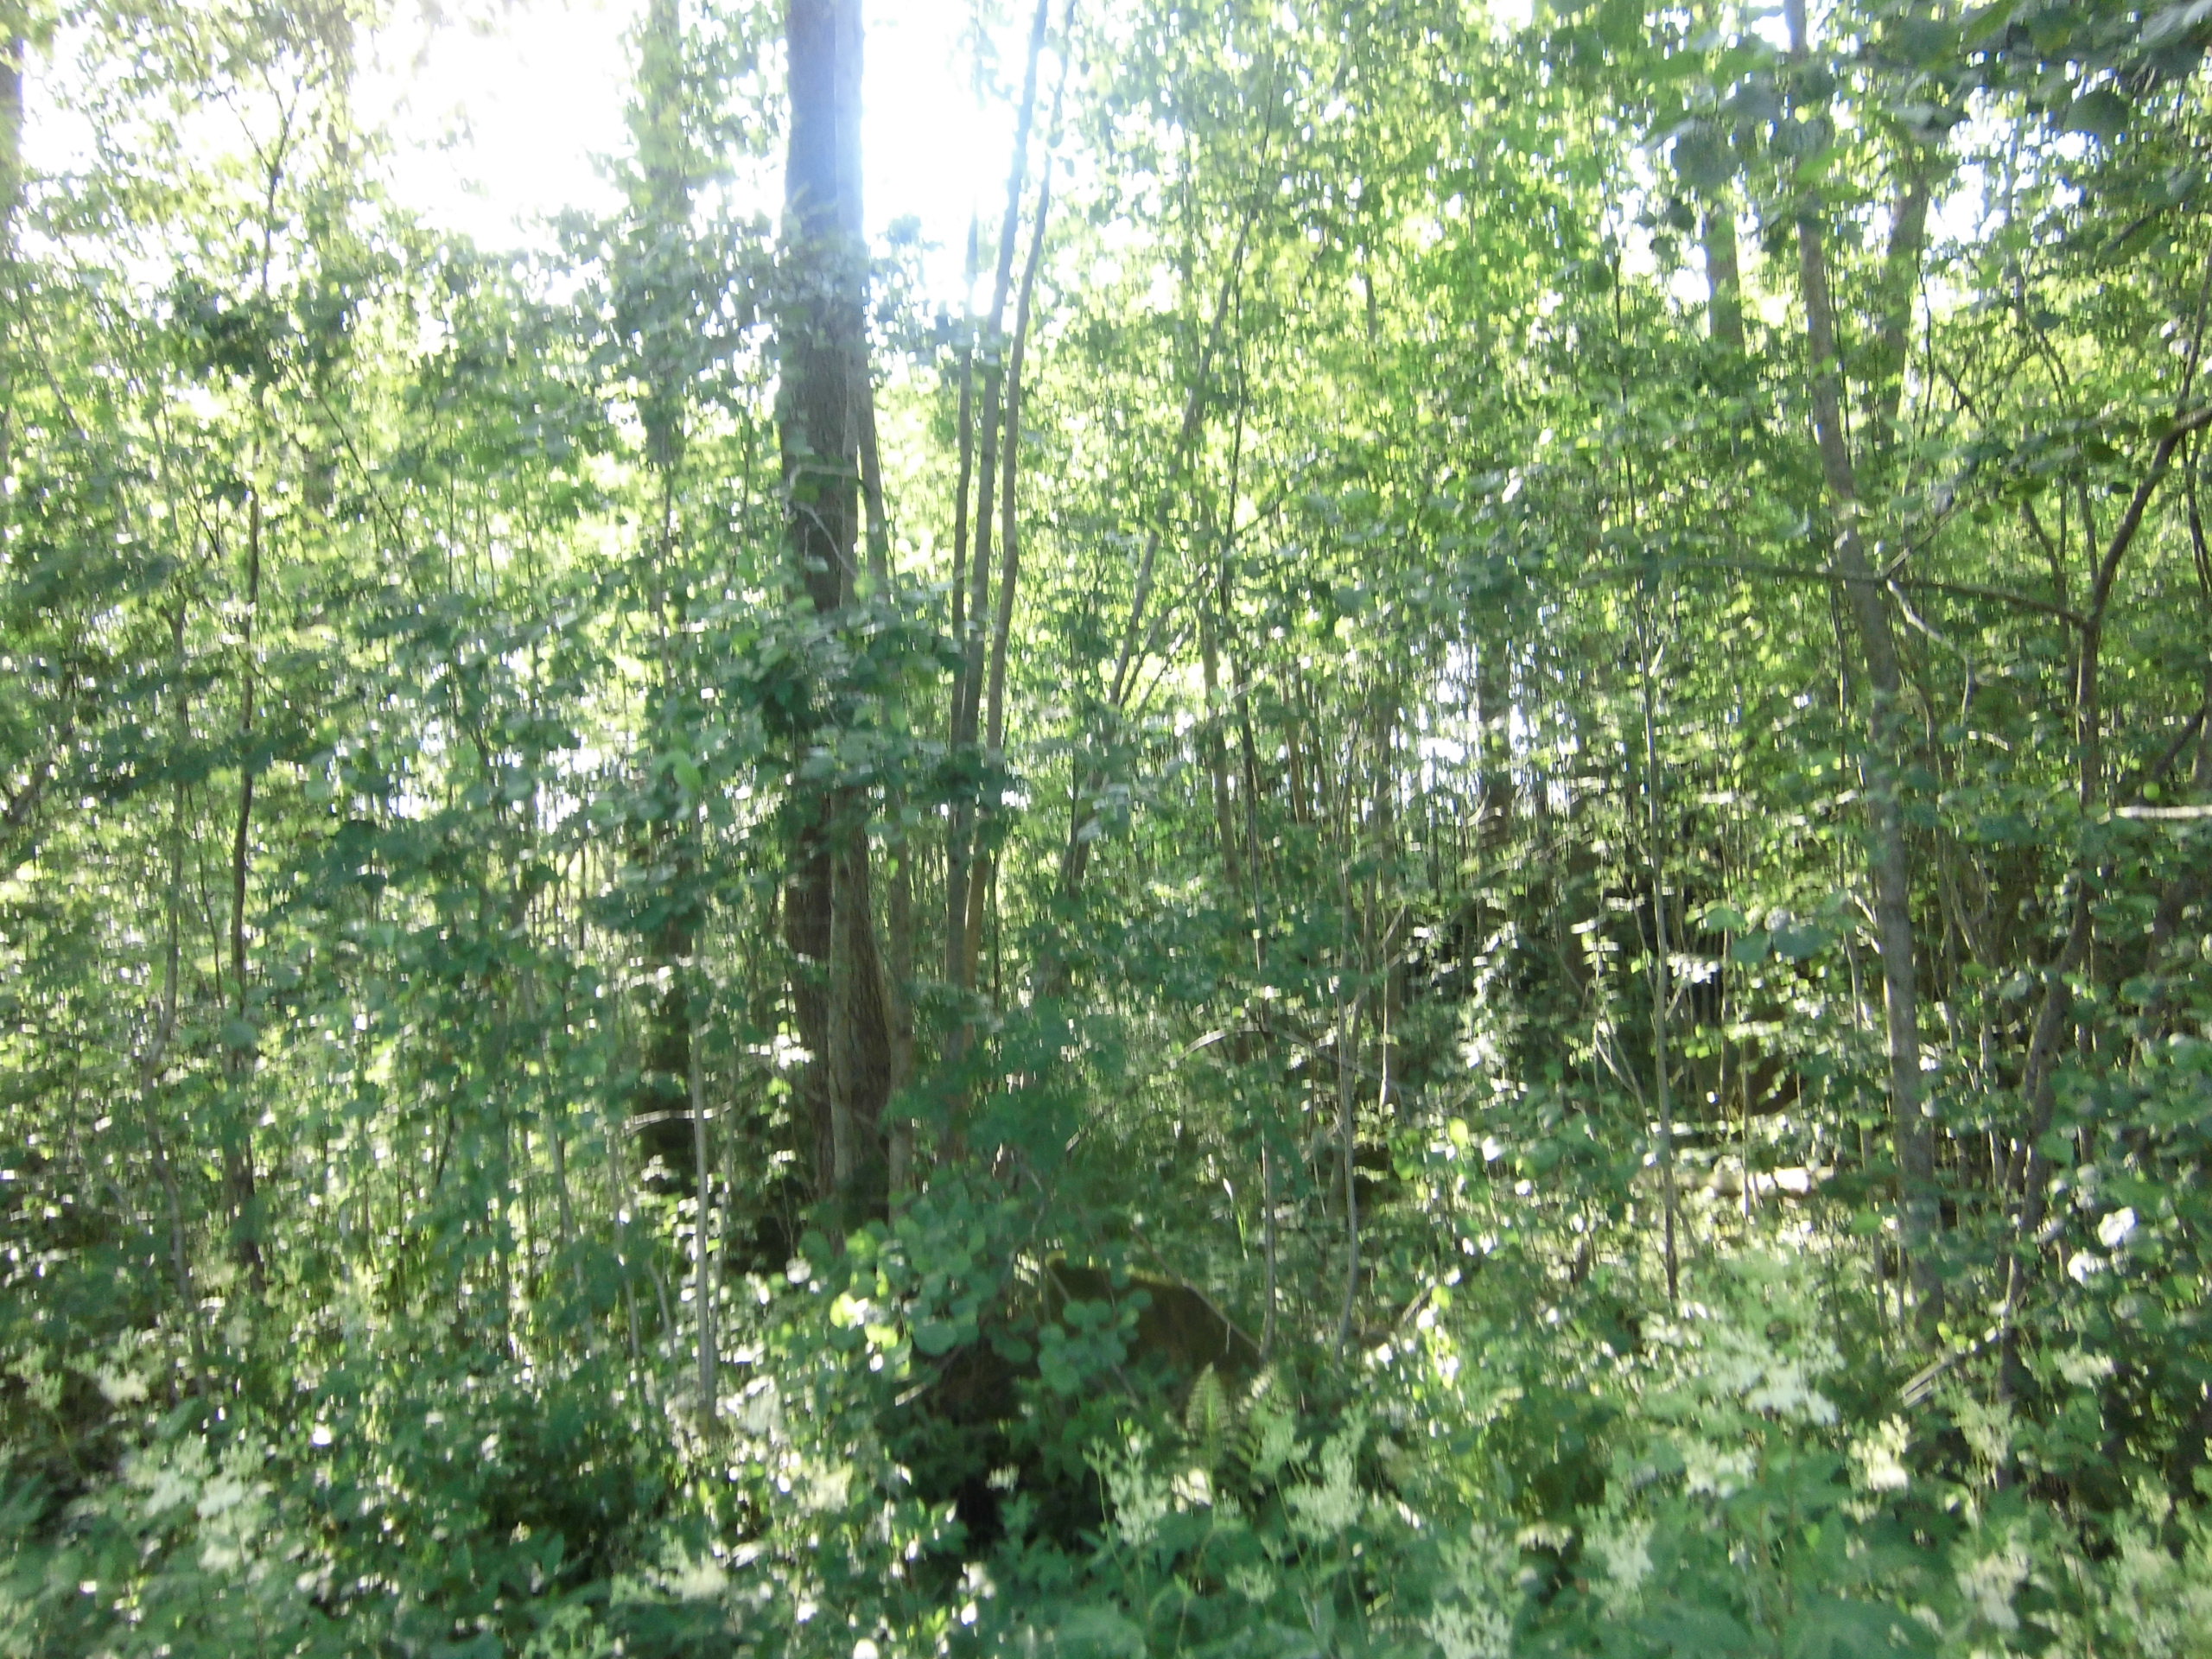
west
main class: Woodland
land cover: Broadleaved woodland
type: boreal forest
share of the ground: 50 - 75 %
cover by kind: broadleaved forest trees 60 %, herbaceous plants 35 %, shrubs 5 %
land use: Forestry
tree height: > 5 m
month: July
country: SE
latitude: 57.3824
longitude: 15.1363
